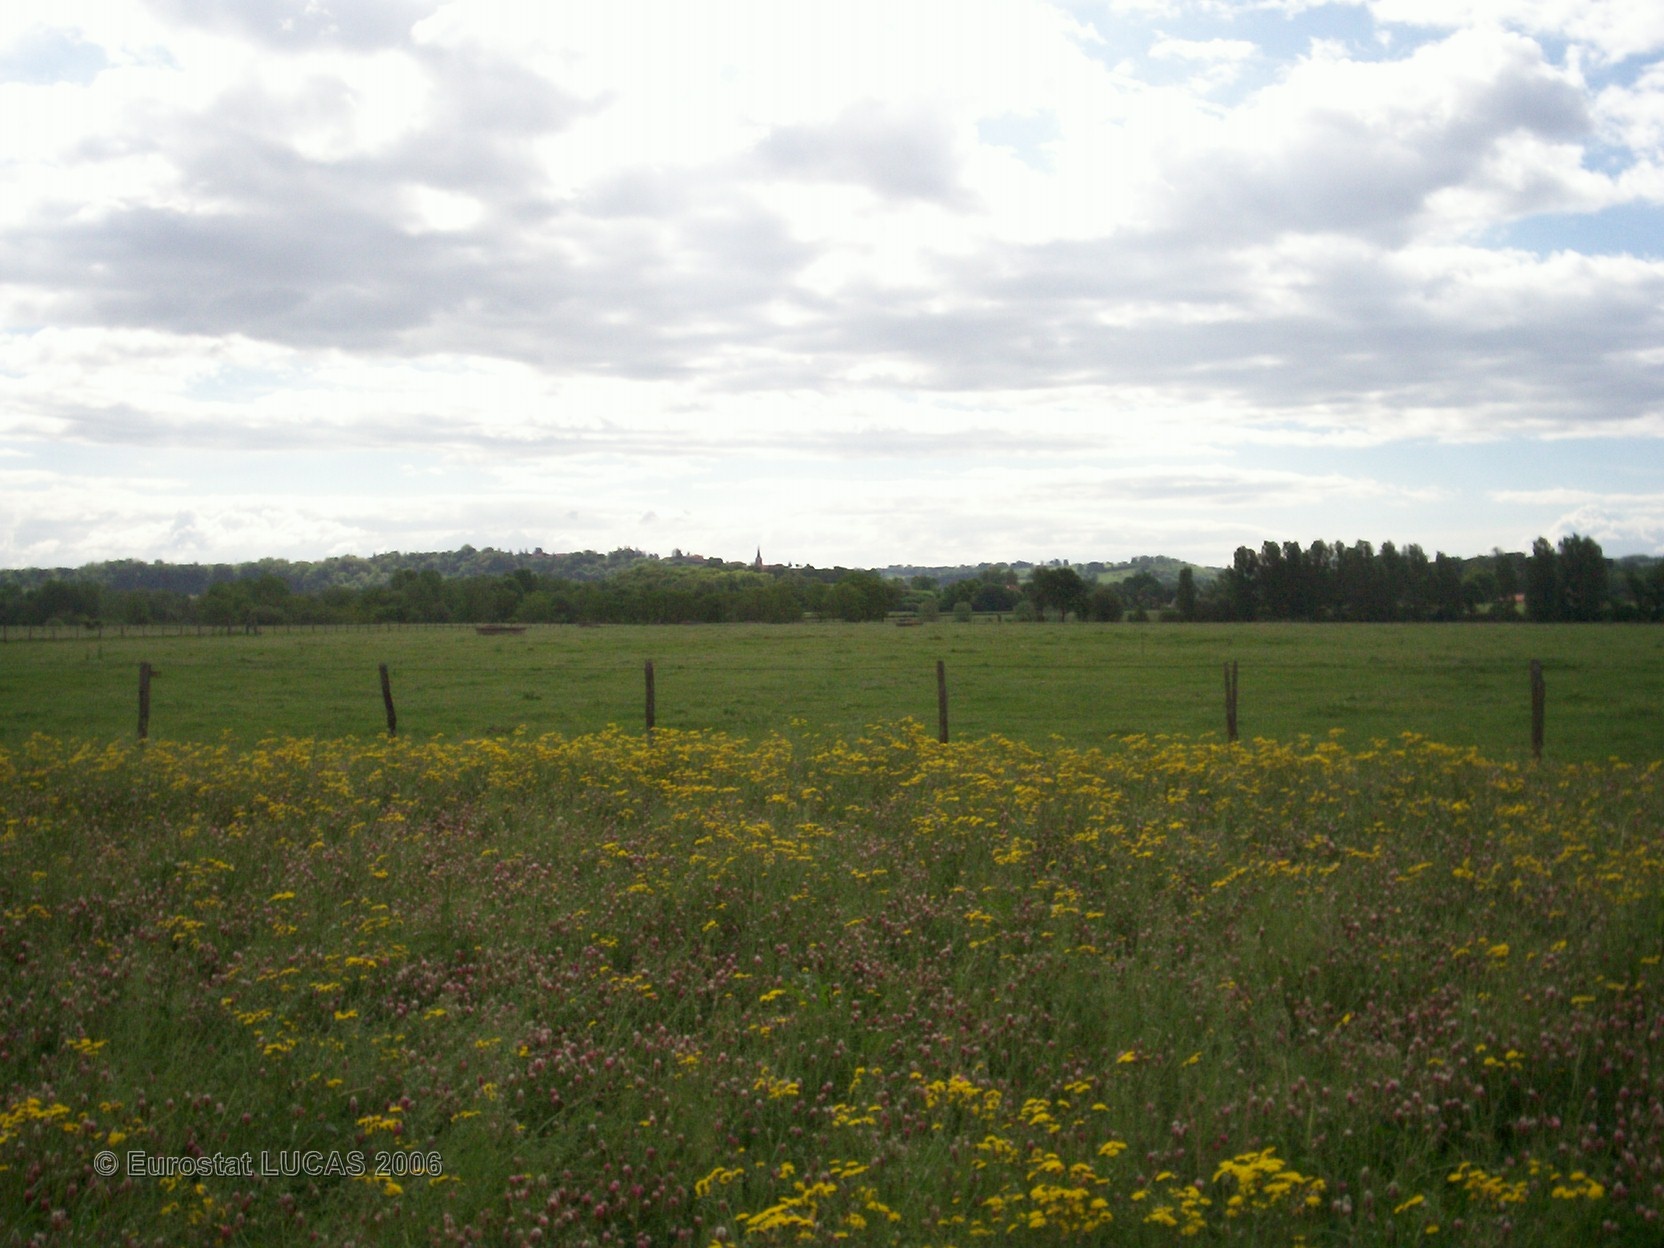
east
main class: Grassland
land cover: Grassland without tree/shrub cover
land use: Agriculture (excluding fallow land and kitchen gardens)
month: May
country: FR
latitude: 46.0436
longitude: 4.0960
